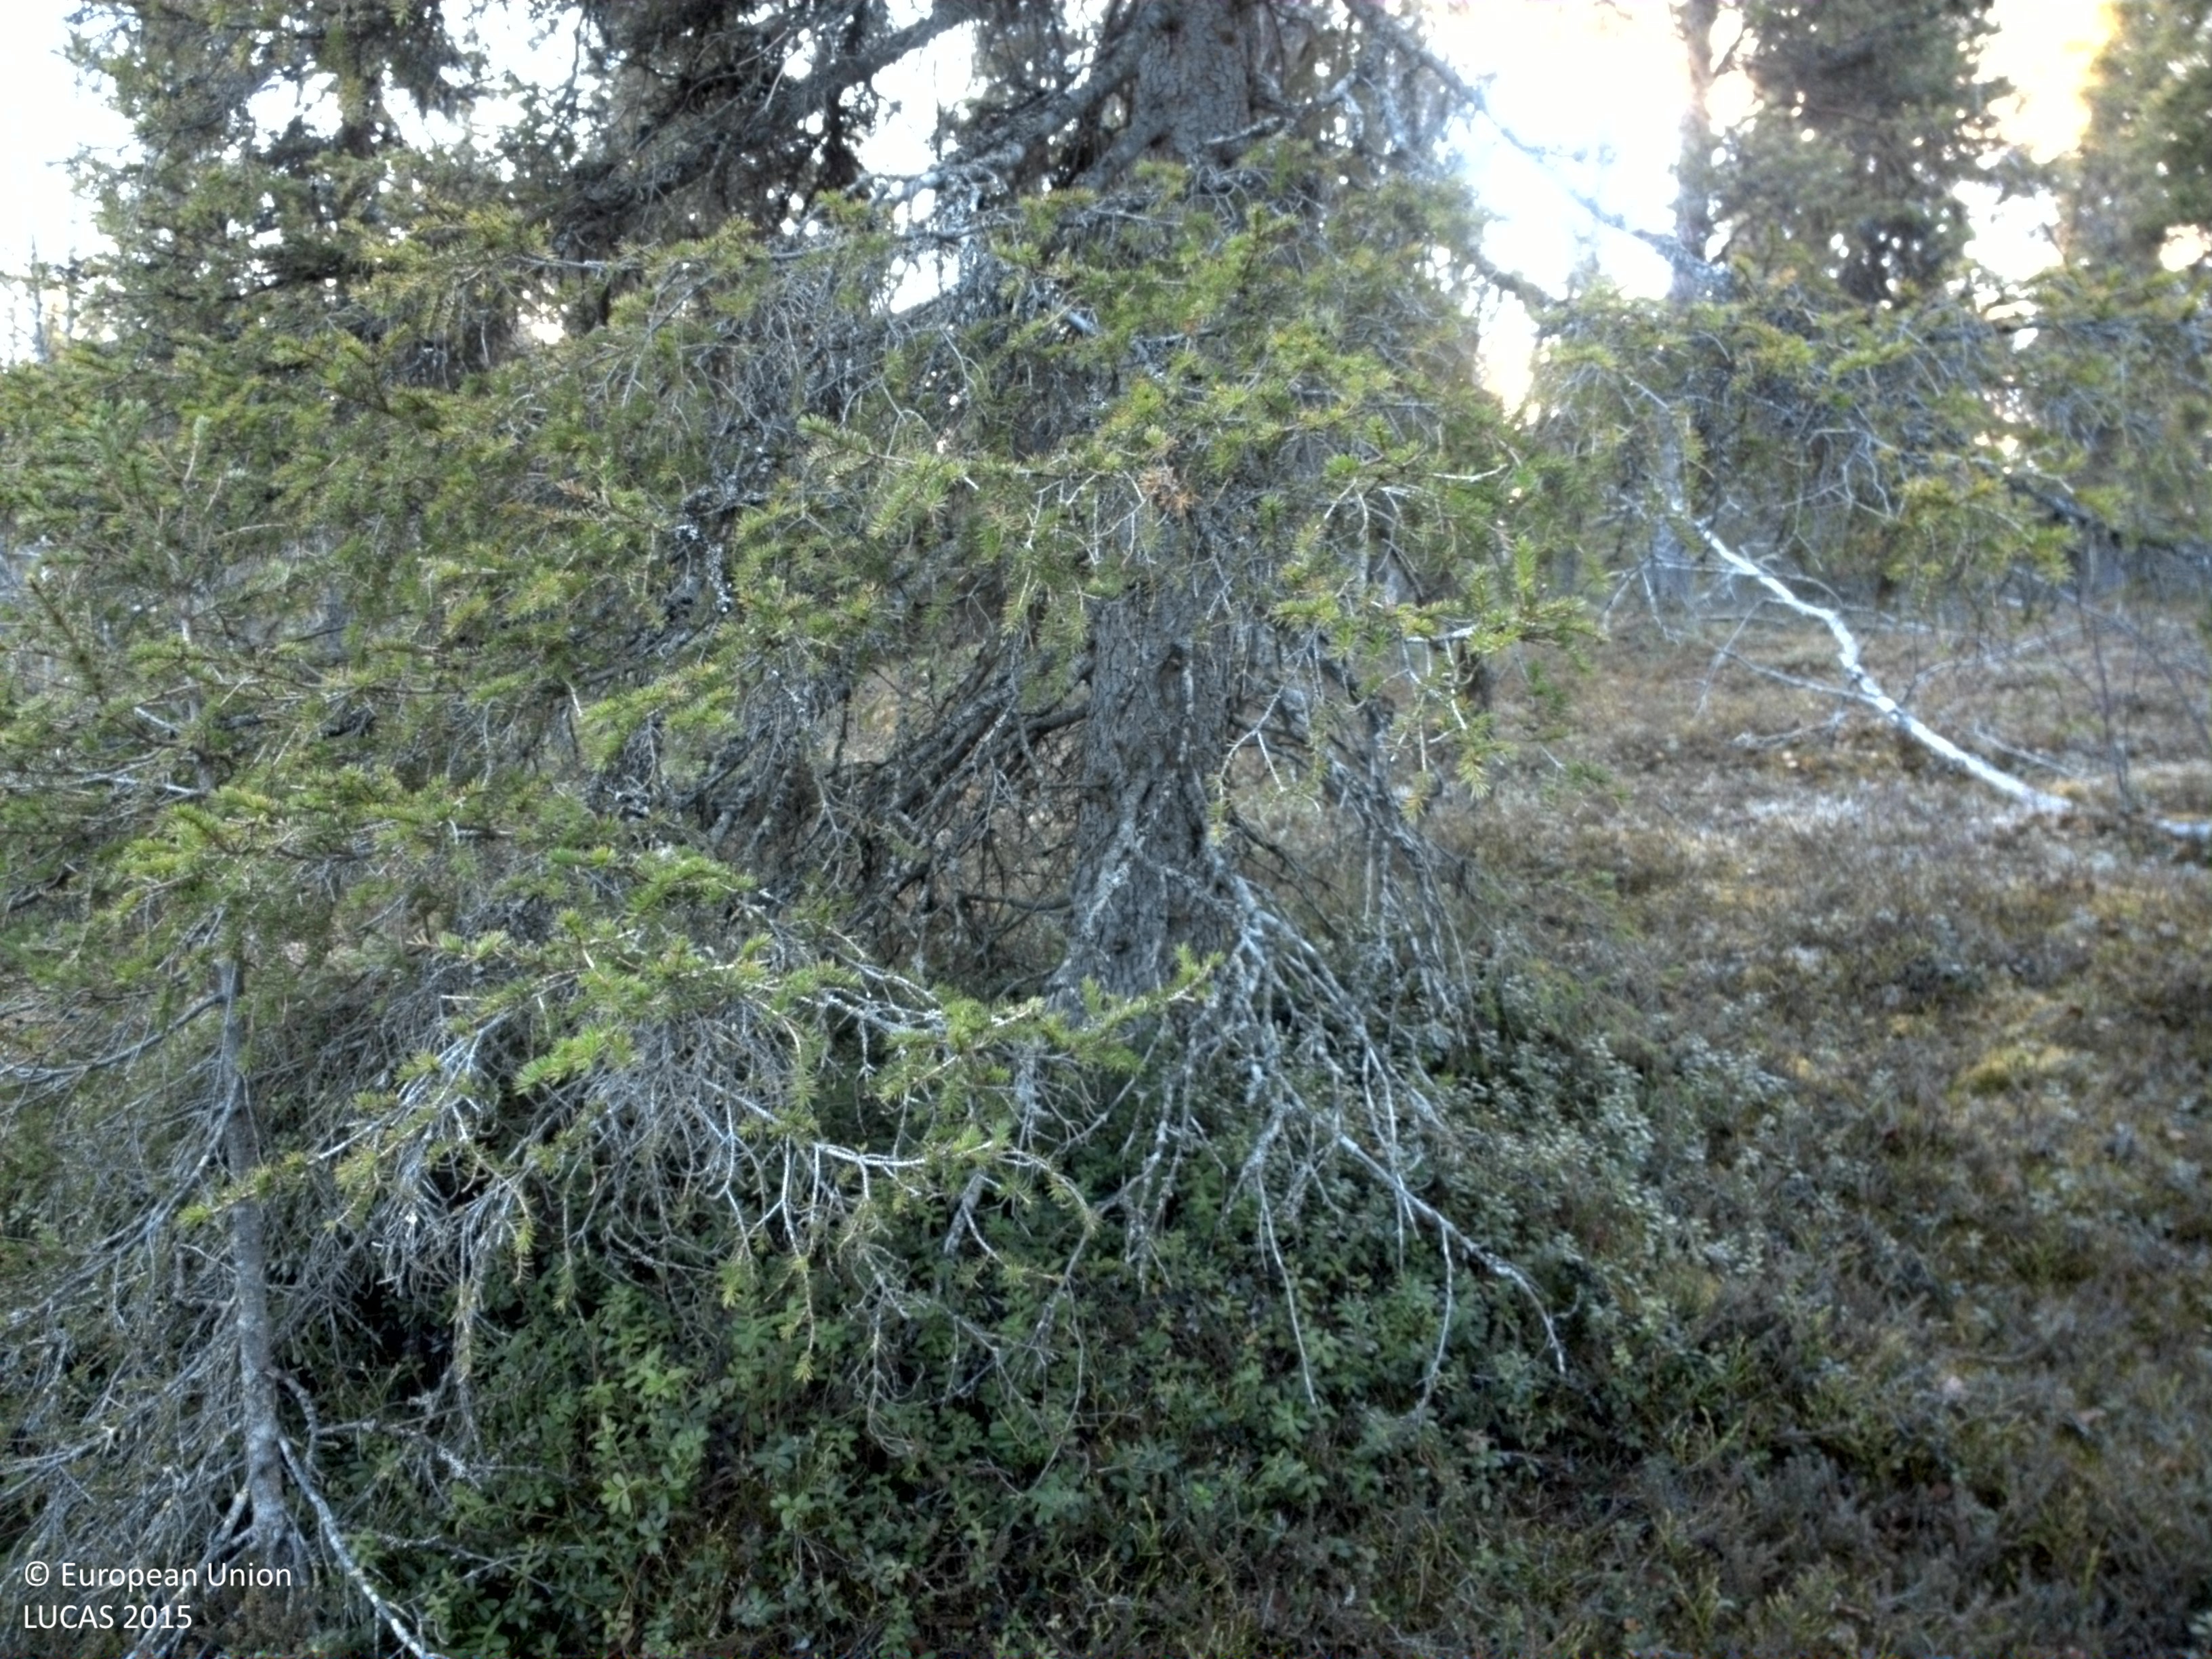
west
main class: Woodland
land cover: Spruce dominated mixed woodland
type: boreal forest
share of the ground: 50 - 75 %
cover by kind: coniferous forest trees 50 %, shrubs 30 %, broadleaved forest trees 20 %
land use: Forestry
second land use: Amenities, museums, leisure
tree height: > 5 m
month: June
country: SE
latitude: 67.2671
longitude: 20.1724
